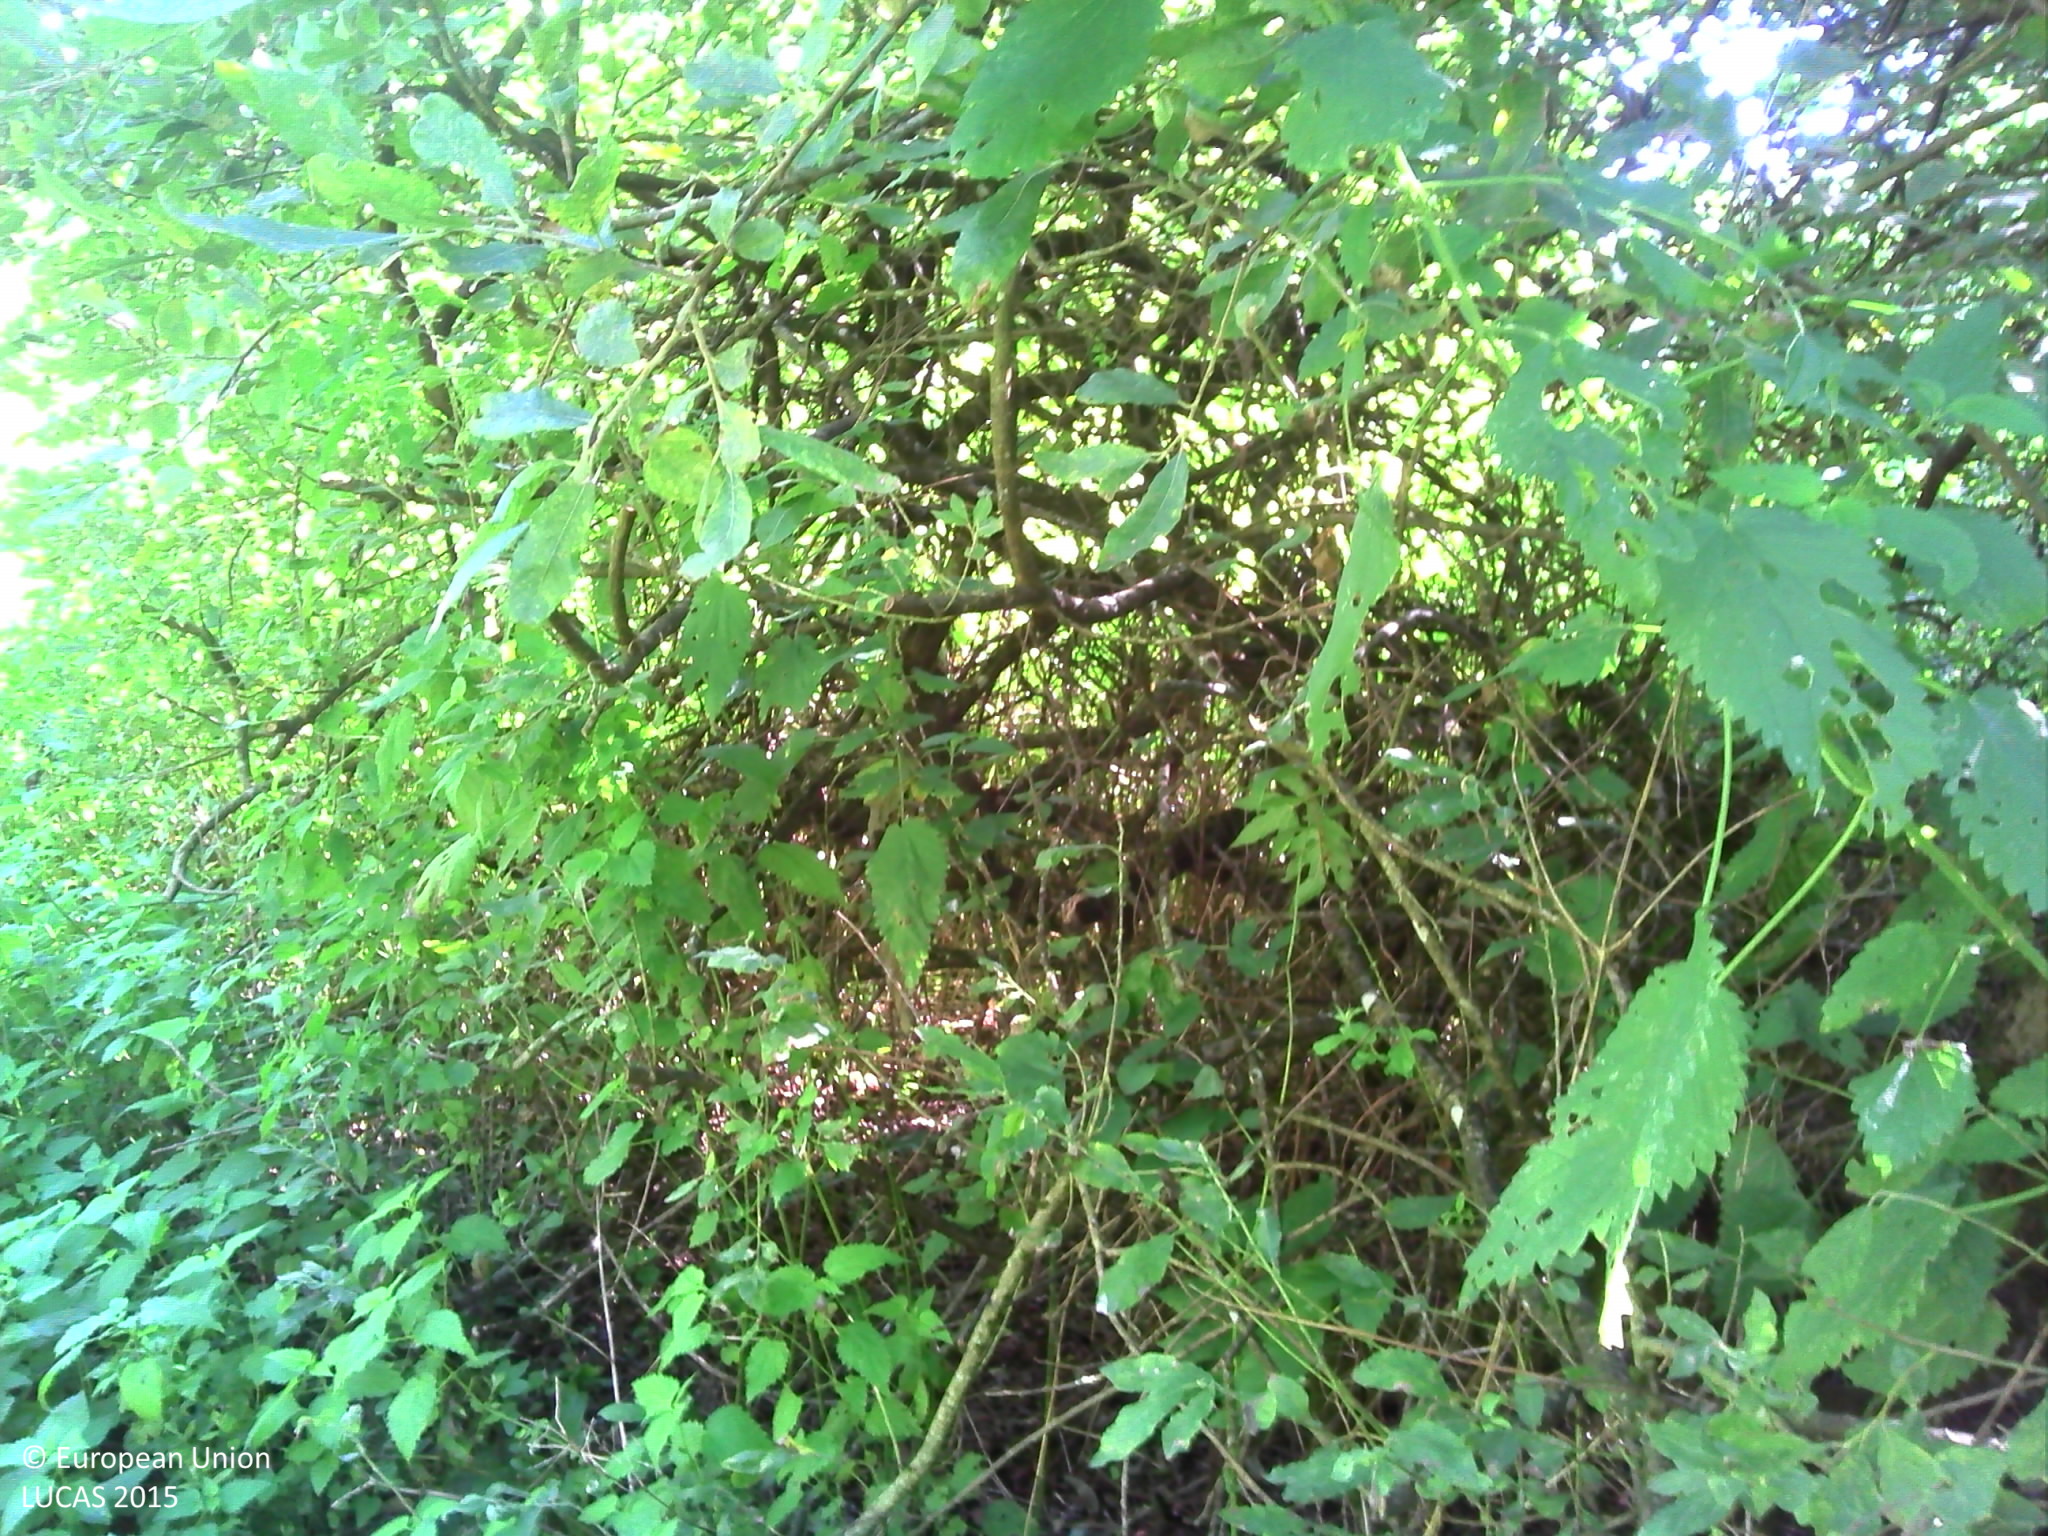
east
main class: Woodland
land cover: Broadleaved woodland
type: floodplain forest
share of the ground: > 75 %
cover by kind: broadleaved forest trees 60 %, shrubs 30 %, herbaceous plants 10 %
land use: Semi-natural and natural areas not in use
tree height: > 5 m
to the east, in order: Broadleaved woodland; Inland fresh running water; Broadleaved woodland; Grassland without tree/shrub cover; Fences; Grassland without tree/shrub cover; Electric lines; Grassland without tree/shrub cover; Fences; Grassland without tree/shrub cover
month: September
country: FR
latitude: 47.2764
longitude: 6.2343
